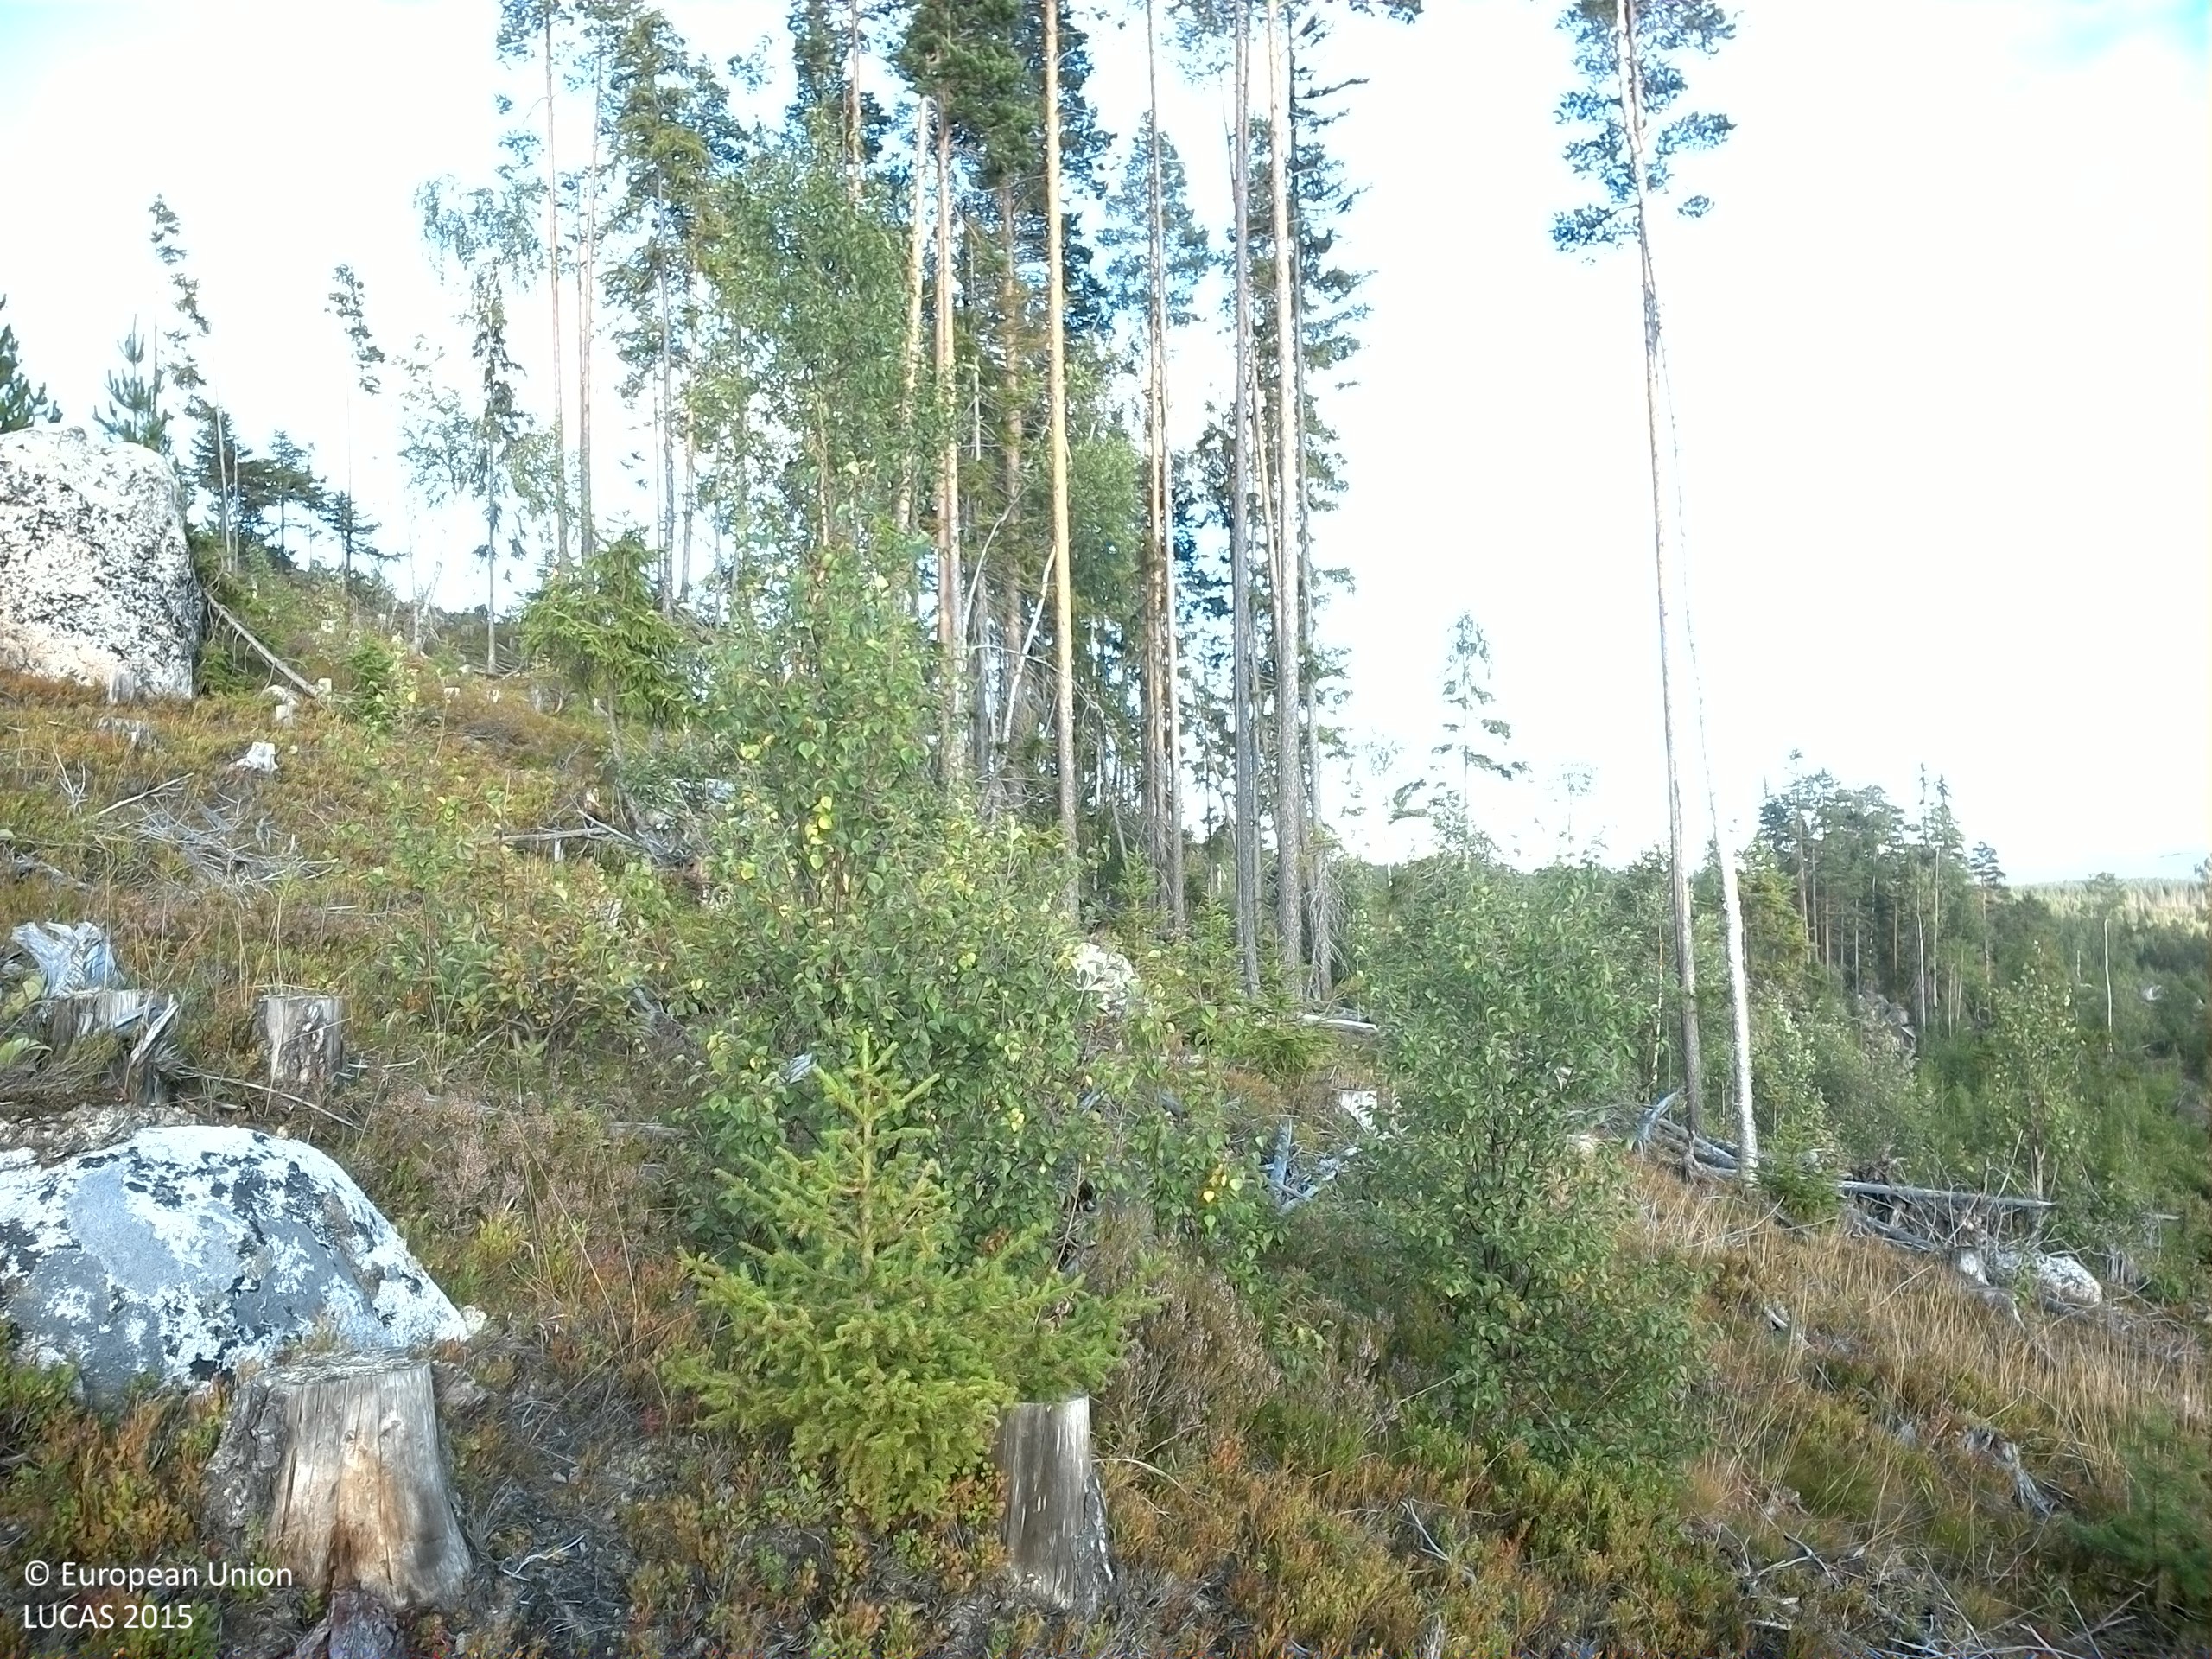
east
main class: Woodland
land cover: Spruce dominated mixed woodland
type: boreal forest
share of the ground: 10 - 25 %
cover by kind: shrubs 45 %, lichens and mosses 25 %, broadleaved forest trees 15 %, coniferous forest trees 10 %, herbaceous plants 5 %
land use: Forestry
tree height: < 5 m
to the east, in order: Spruce dominated mixed woodland; Pine dominated coniferous woodland; Spruce dominated mixed woodland; Pine dominated coniferous woodland
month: August
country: SE
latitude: 64.0816
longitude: 17.3726
